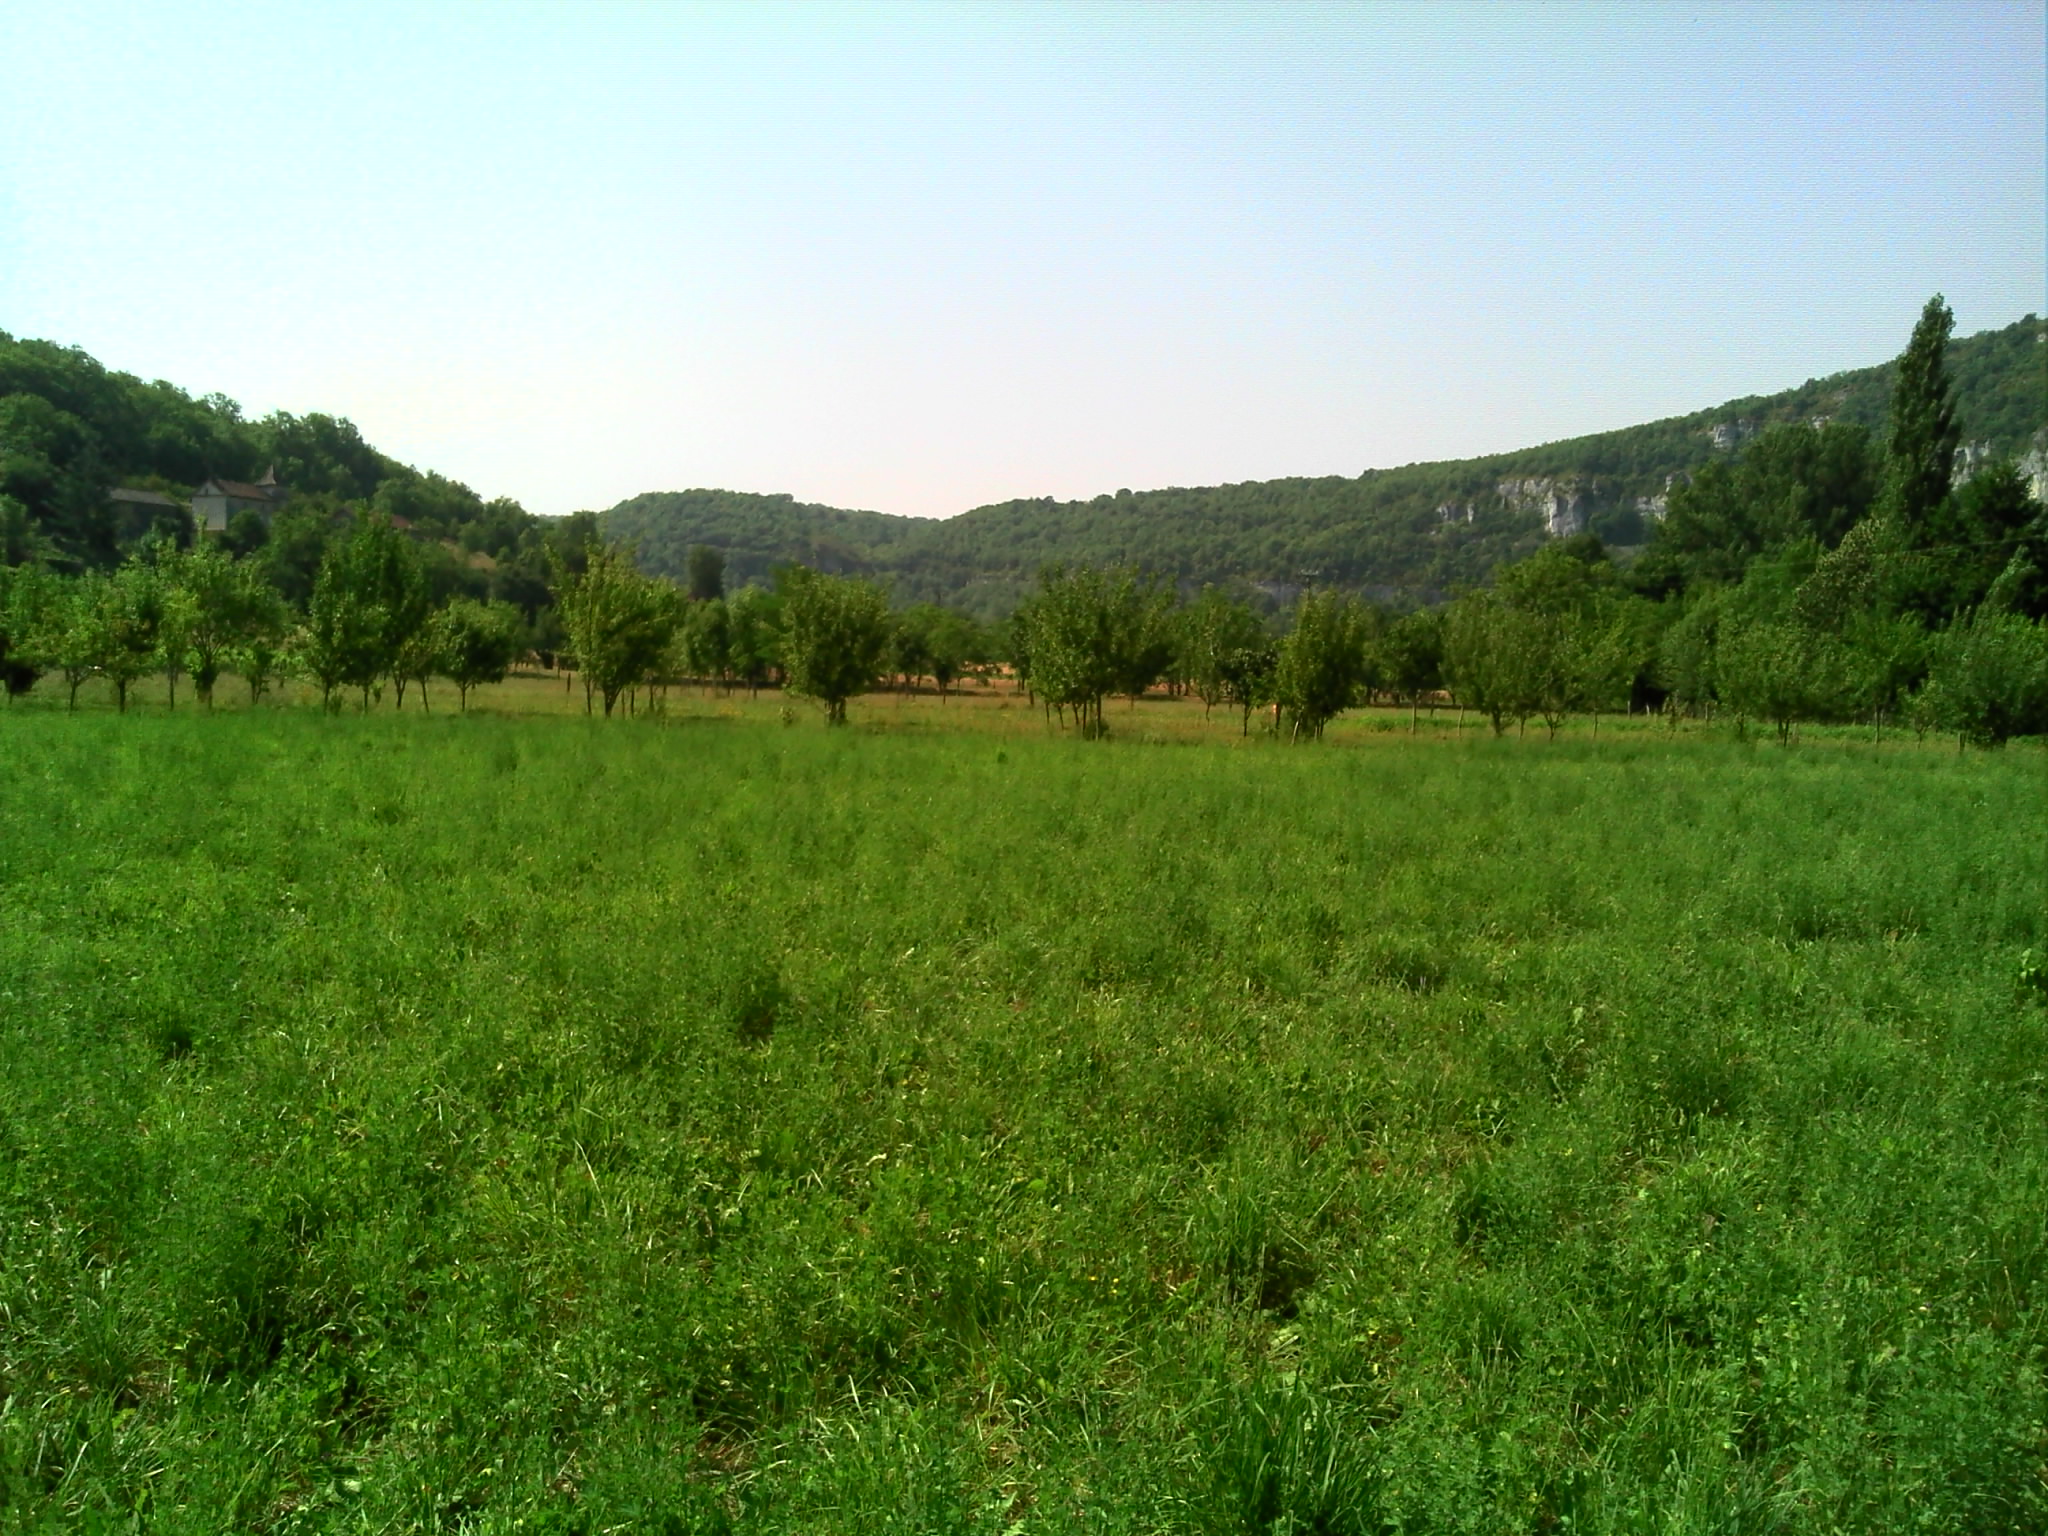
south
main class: Cropland
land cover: Lucerne
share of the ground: > 75 %
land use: Agriculture (excluding fallow land and kitchen gardens)
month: July
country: FR
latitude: 44.5694
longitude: 1.8020
